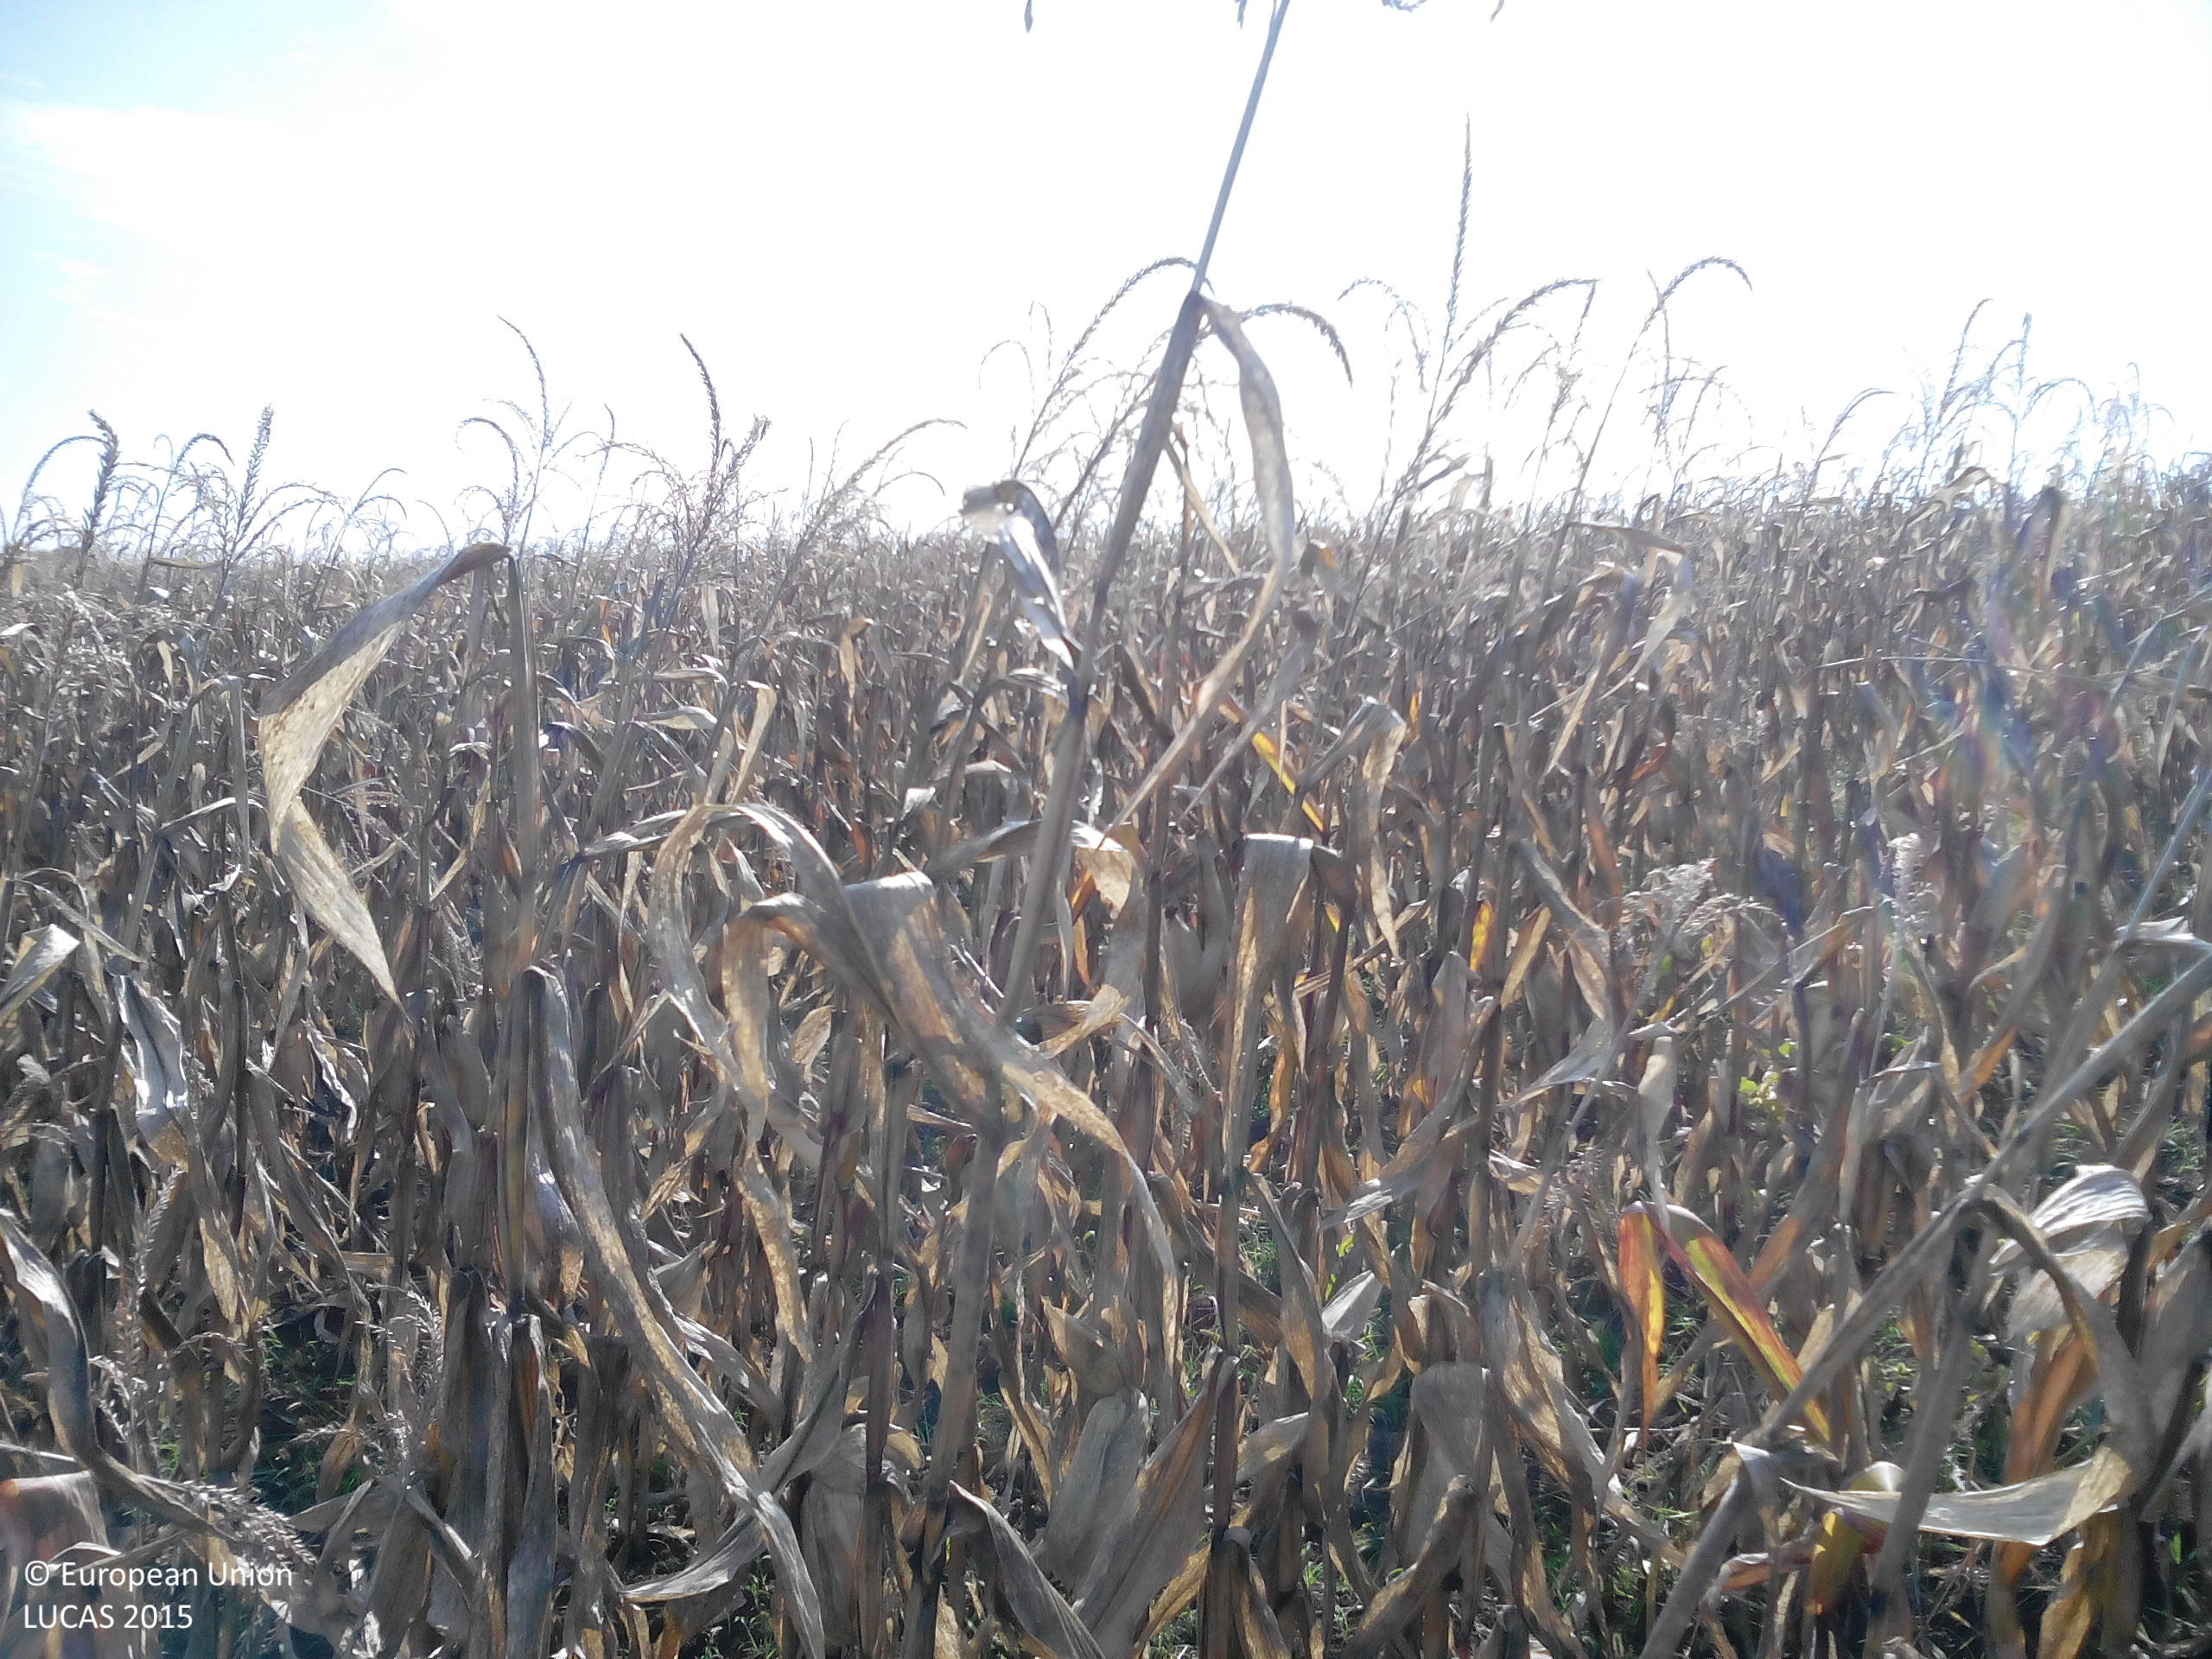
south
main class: Cropland
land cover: Maize
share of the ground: > 75 %
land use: Agriculture (excluding fallow land and kitchen gardens)
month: October
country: BG
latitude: 43.3485
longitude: 23.6781
